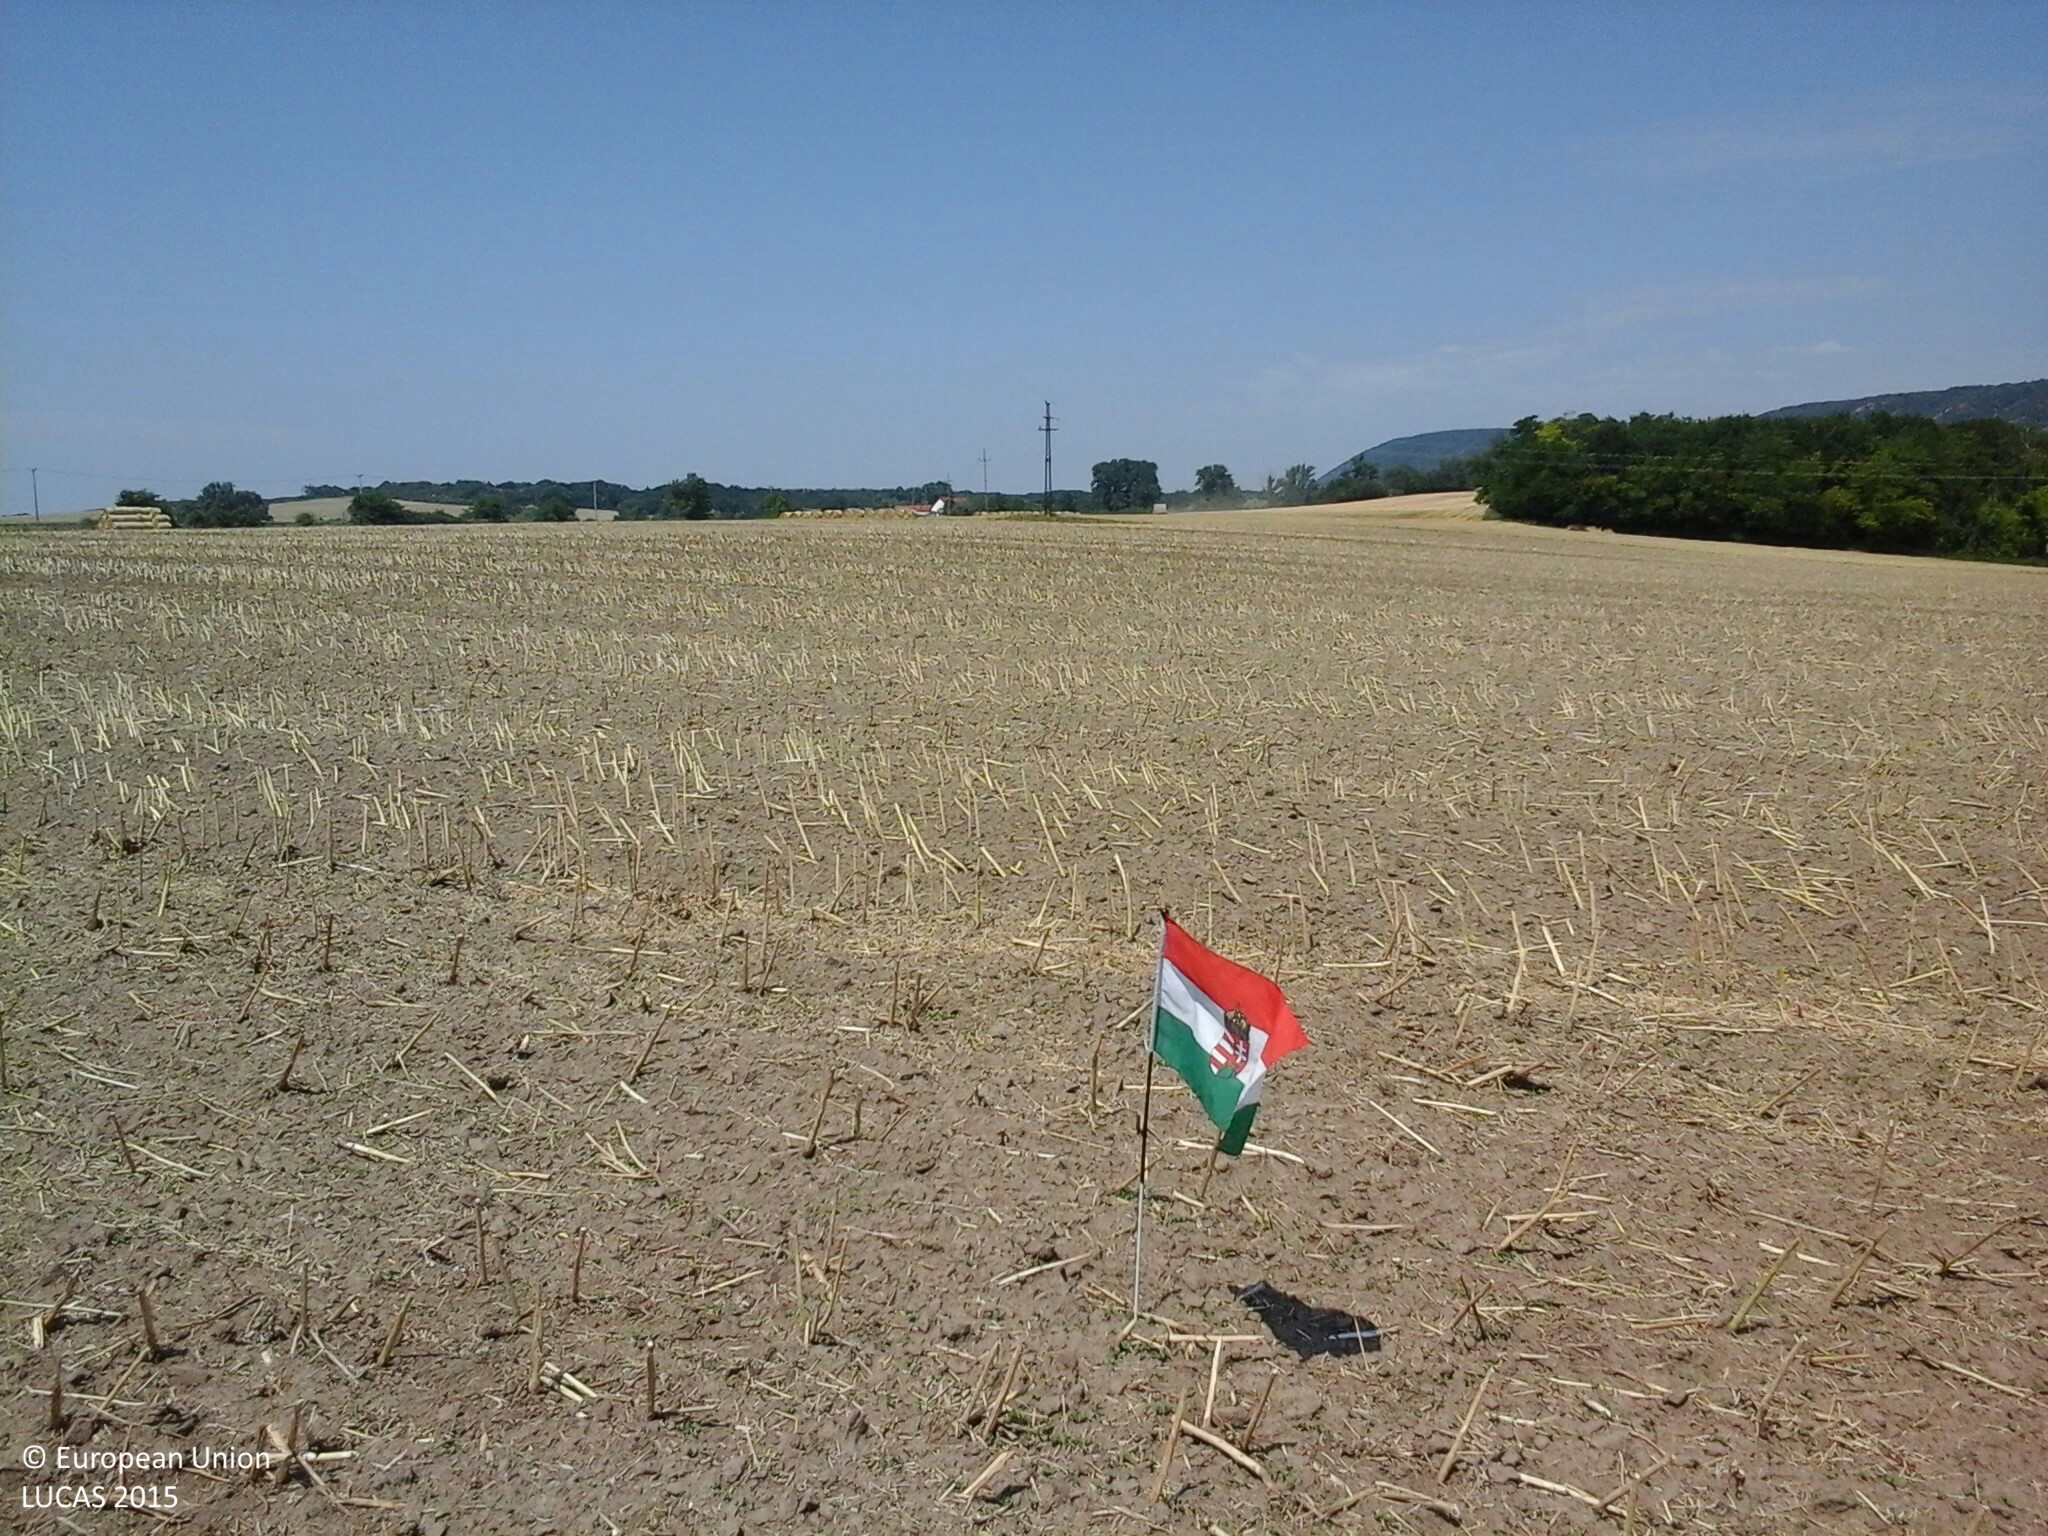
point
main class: Cropland
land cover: Rape and turnip rape
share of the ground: 10 - 25 %
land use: Agriculture (excluding fallow land and kitchen gardens)
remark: Harvested field
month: July
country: HU
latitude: 47.3306
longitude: 18.3090
